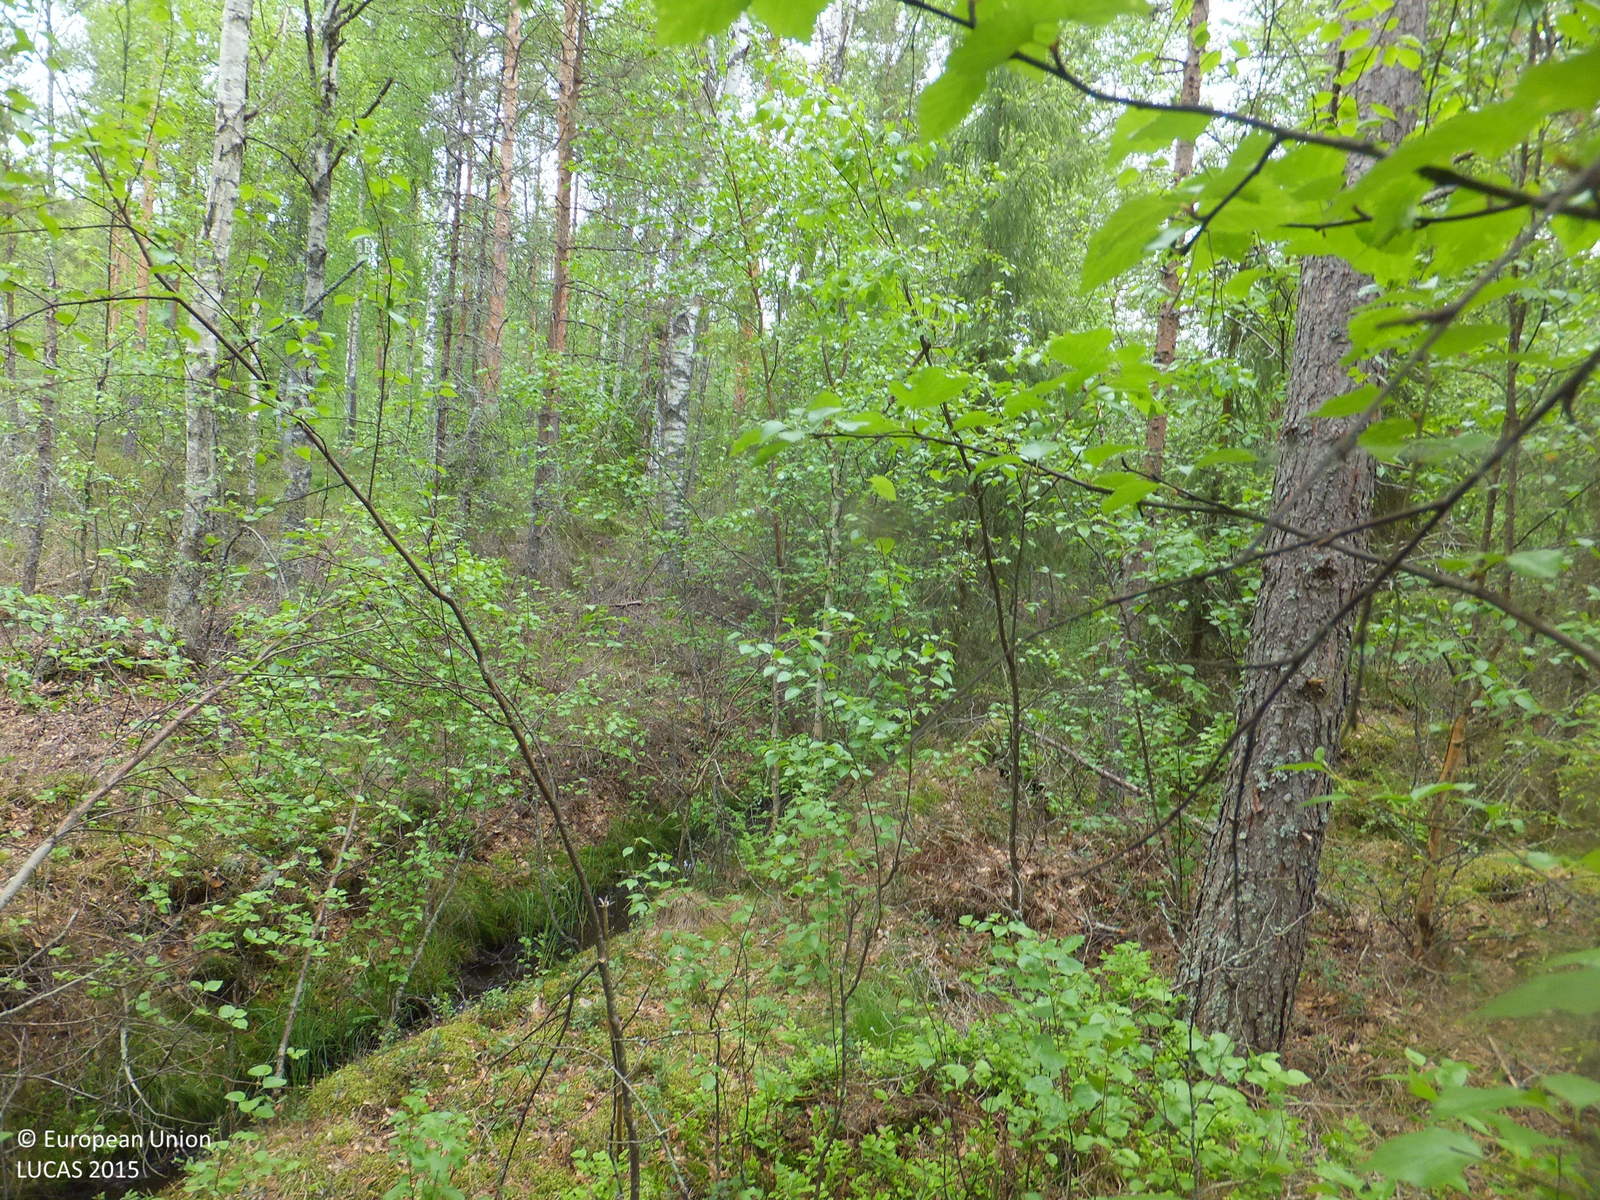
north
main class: Woodland
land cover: Pine dominated mixed woodland
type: boreal forest
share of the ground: > 75 %
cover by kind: coniferous forest trees 70 %, broadleaved forest trees 25 %, shrubs 5 %
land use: Forestry
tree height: > 5 m
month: June
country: FI
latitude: 63.3184
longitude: 22.6869
